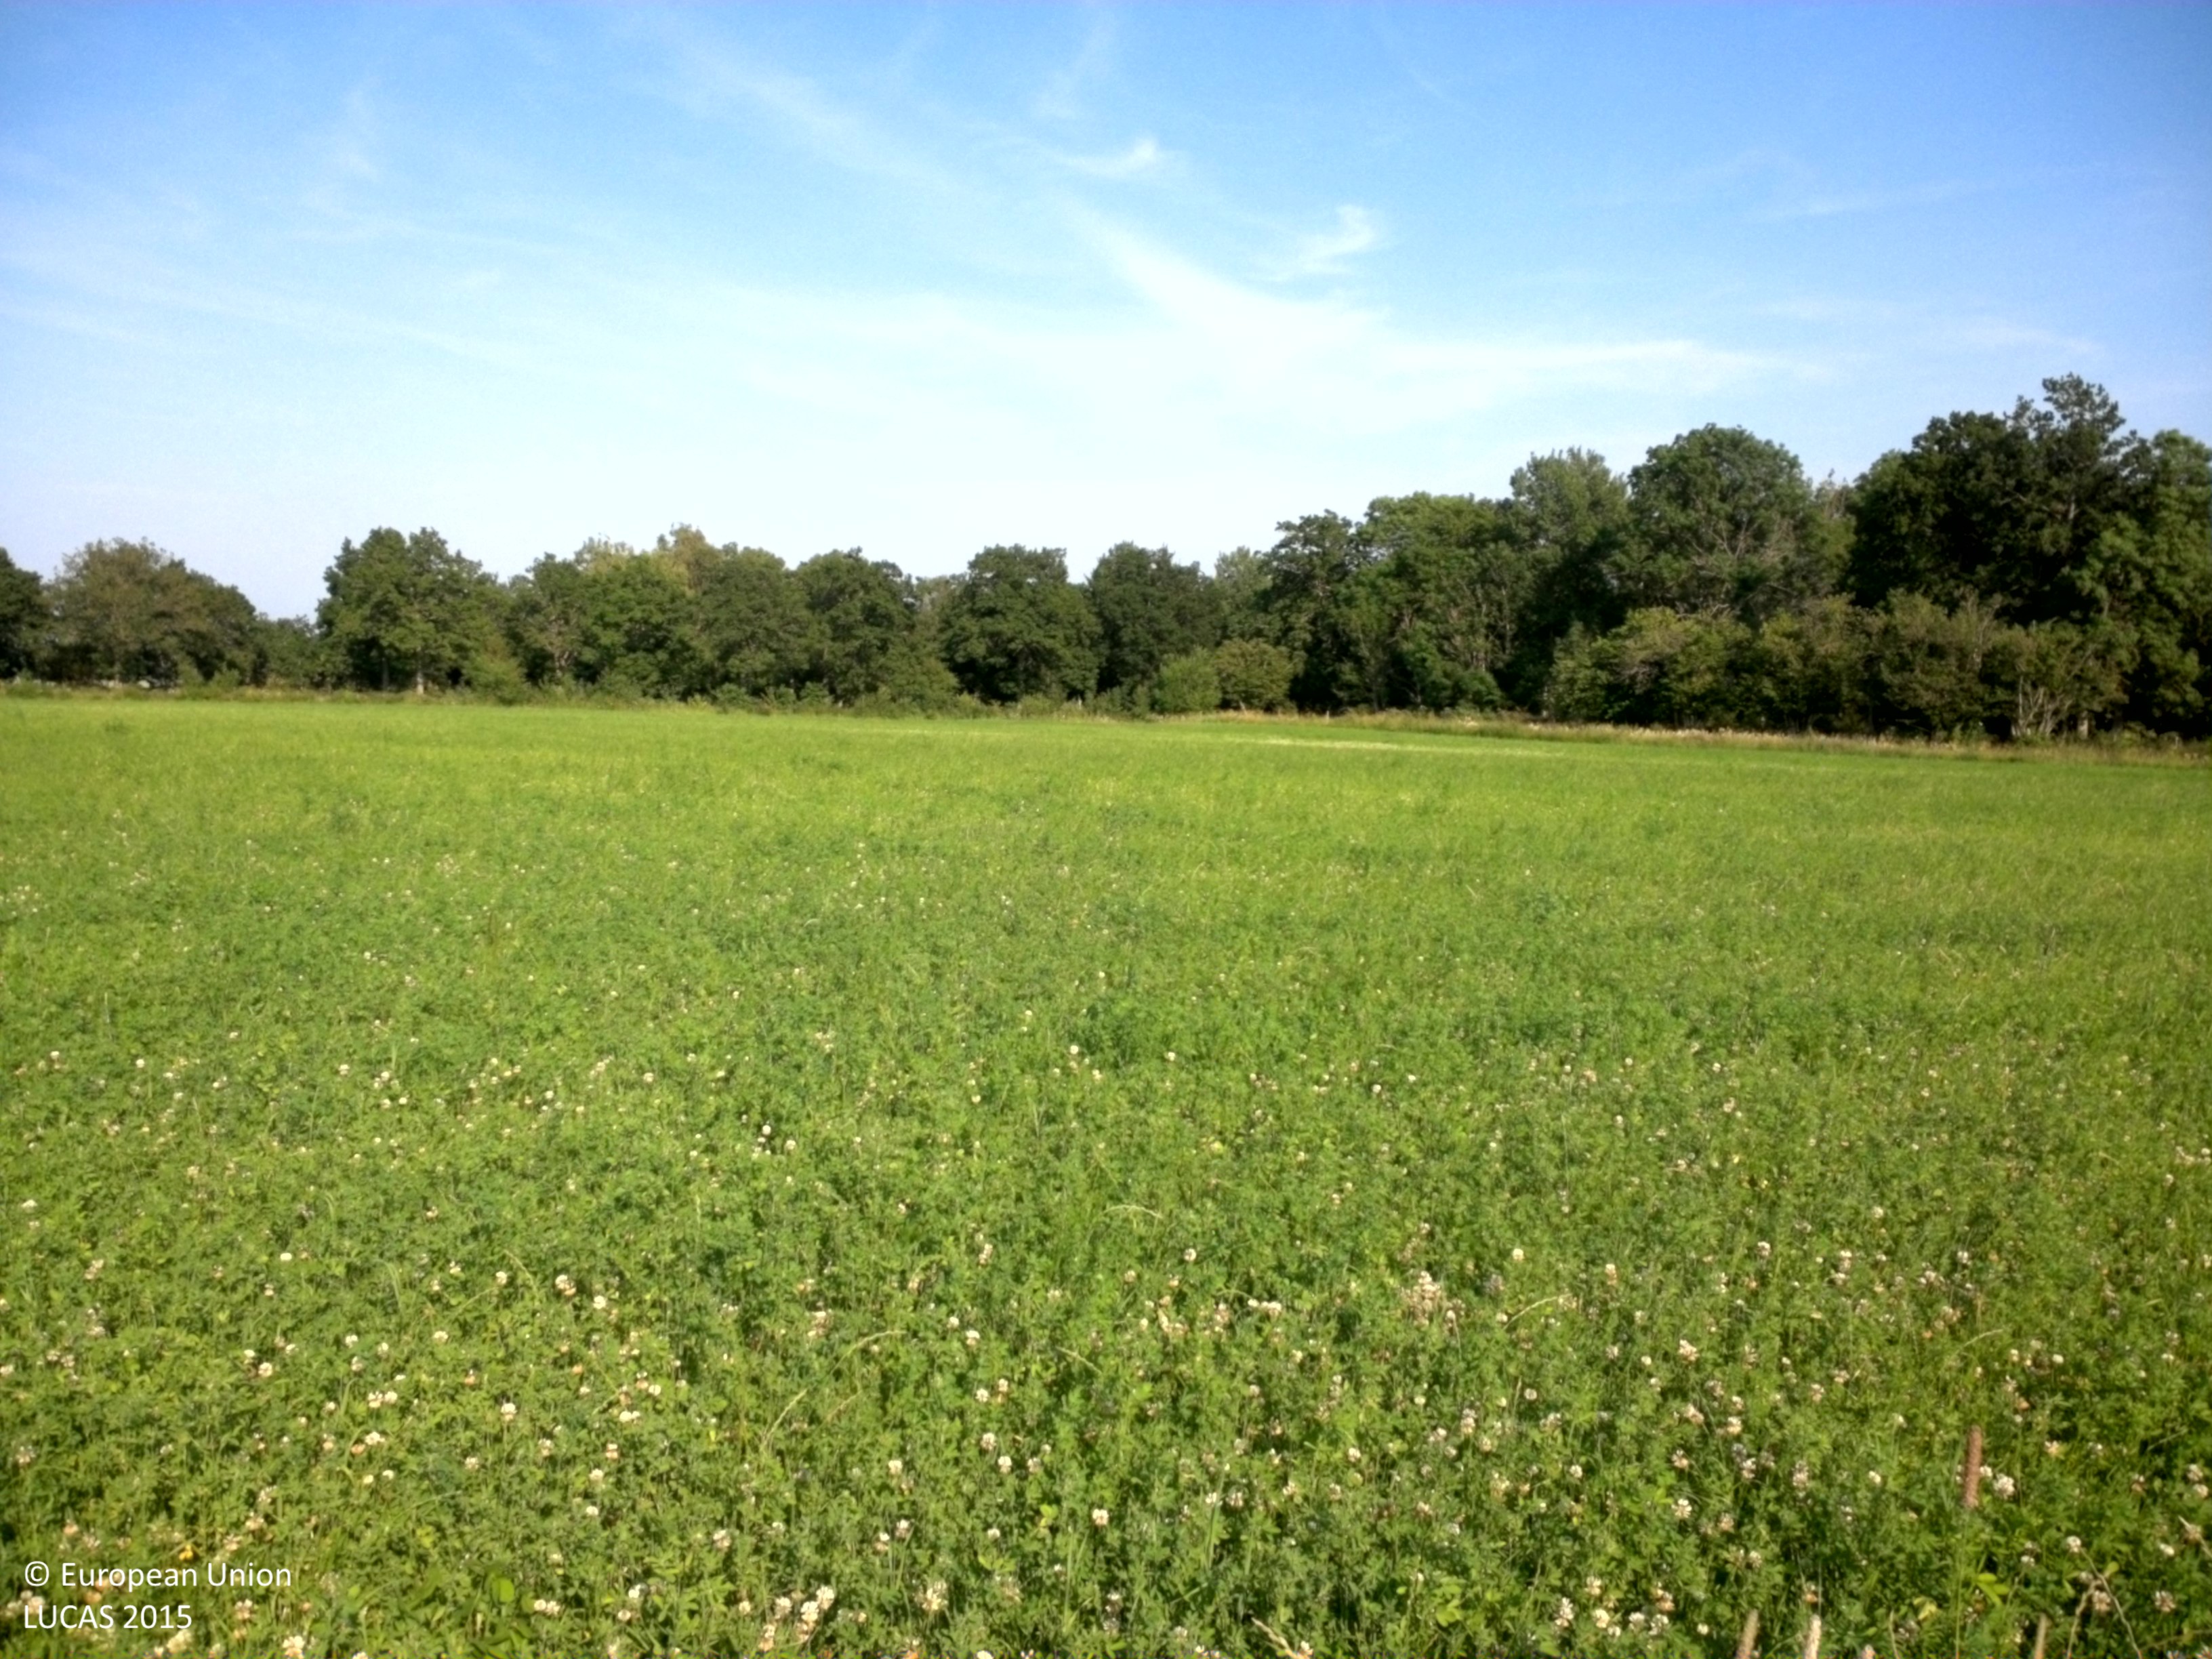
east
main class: Cropland
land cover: Barley
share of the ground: > 75 %
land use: Agriculture (excluding fallow land and kitchen gardens)
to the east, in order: Barley; Clovers; Ditches and canals; Abandoned hedges; Fences; Shrubland with sparse tree cover; Broadleaved woodland; Grassland without tree/shrub cover; Fences; Barley
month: July
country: SE
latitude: 57.6401
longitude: 18.5349
